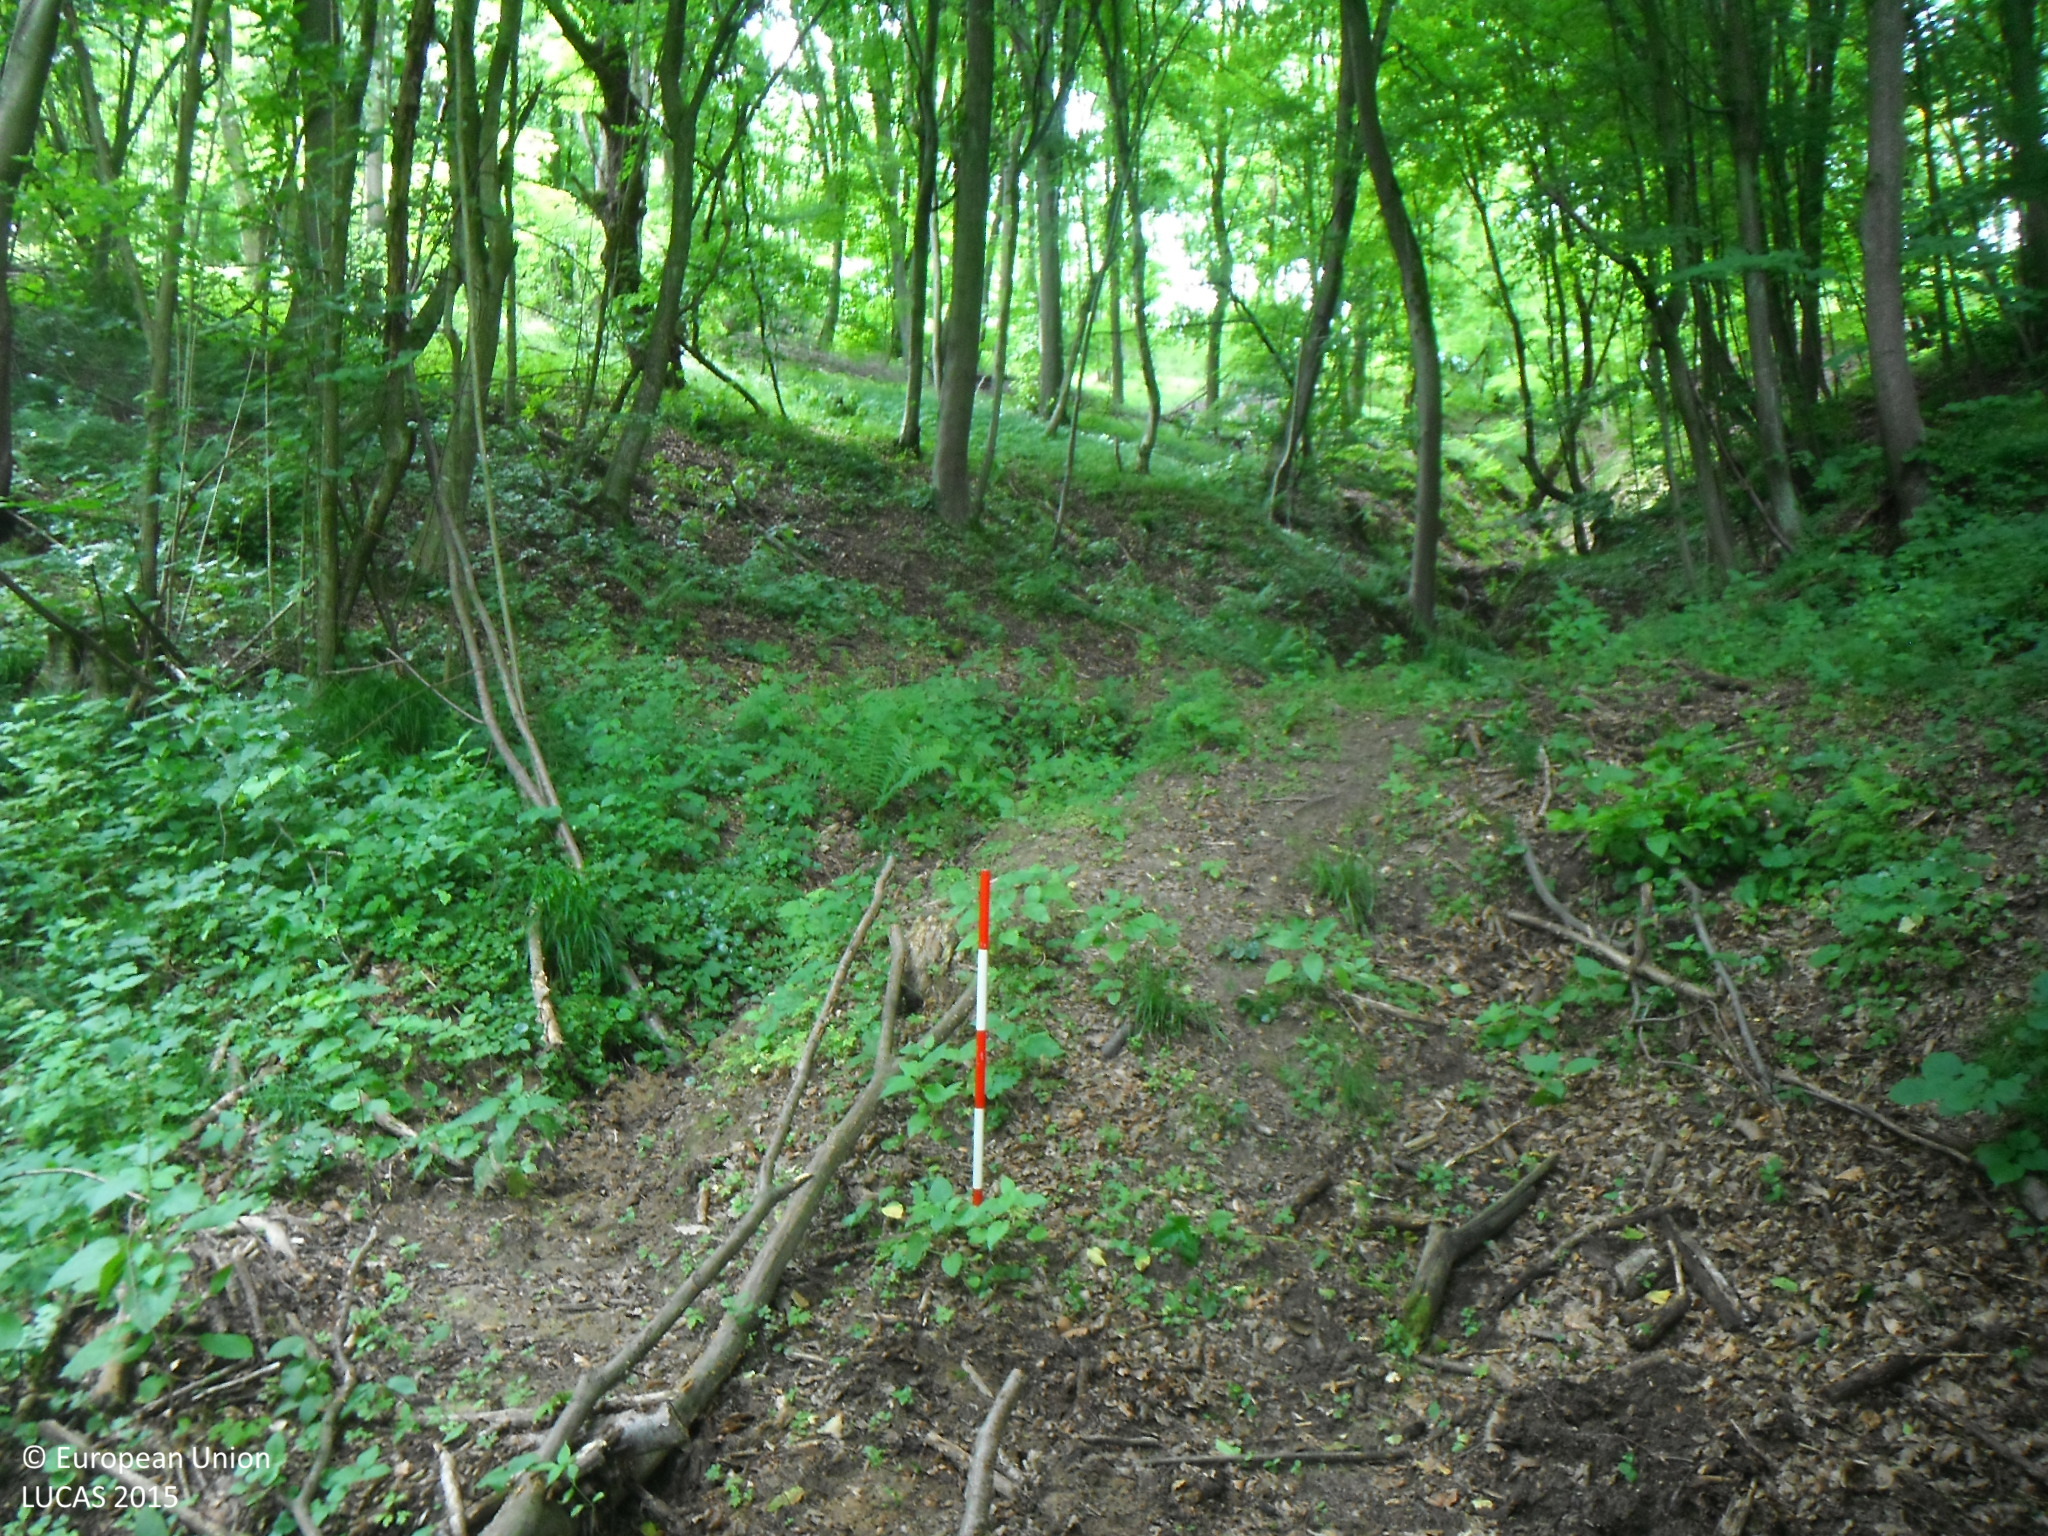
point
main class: Woodland
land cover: Broadleaved woodland
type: beech forest
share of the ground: > 75 %
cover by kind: broadleaved forest trees 90 %, herbaceous plants 5 %, consolidated bare surface 5 %
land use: Forestry
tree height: > 5 m
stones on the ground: < 10 %
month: June
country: SK
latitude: 48.9915
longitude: 21.9307
